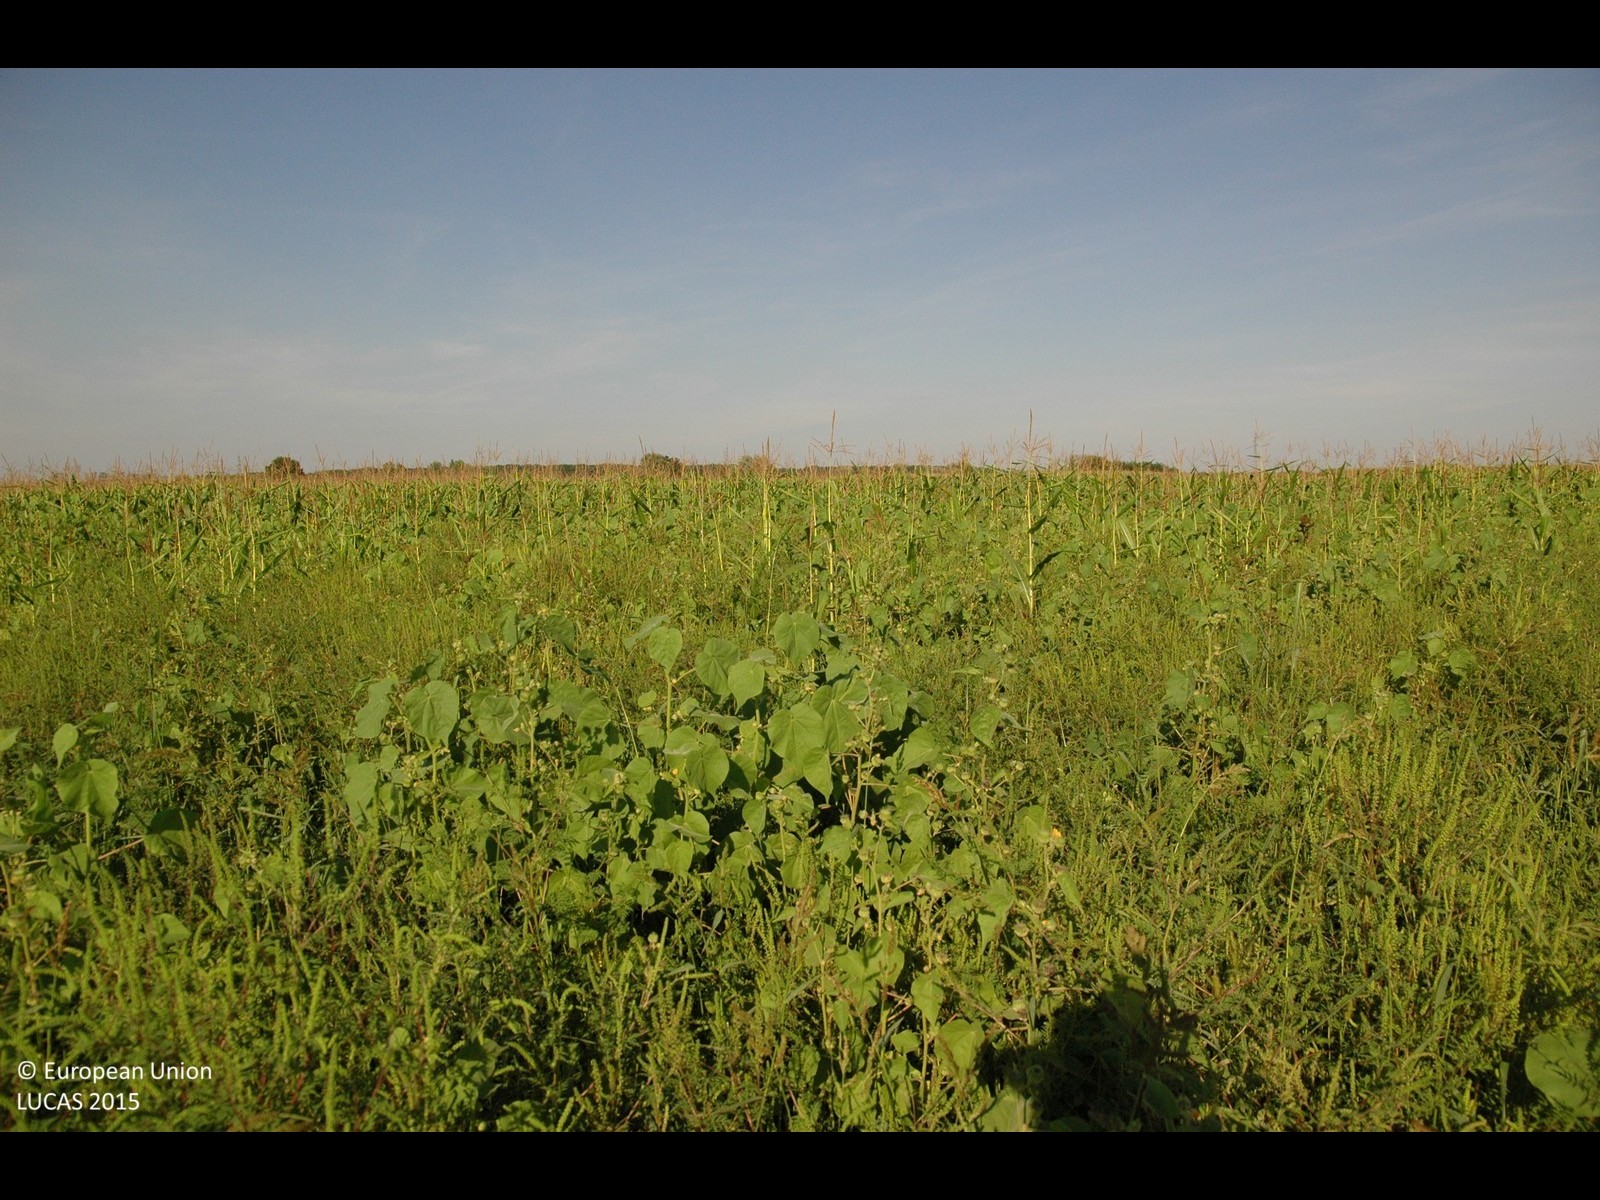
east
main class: Grassland
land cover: Spontaneously vegetated surfaces
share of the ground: > 75 %
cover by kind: herbaceous plants 100 %
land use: Fallow land
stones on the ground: < 10 %
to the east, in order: Spontaneously vegetated surfaces; Maize; Grass margins; Ditches and canals; Grass margins; Common wheat
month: August
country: HR
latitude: 46.1250
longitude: 16.9512
